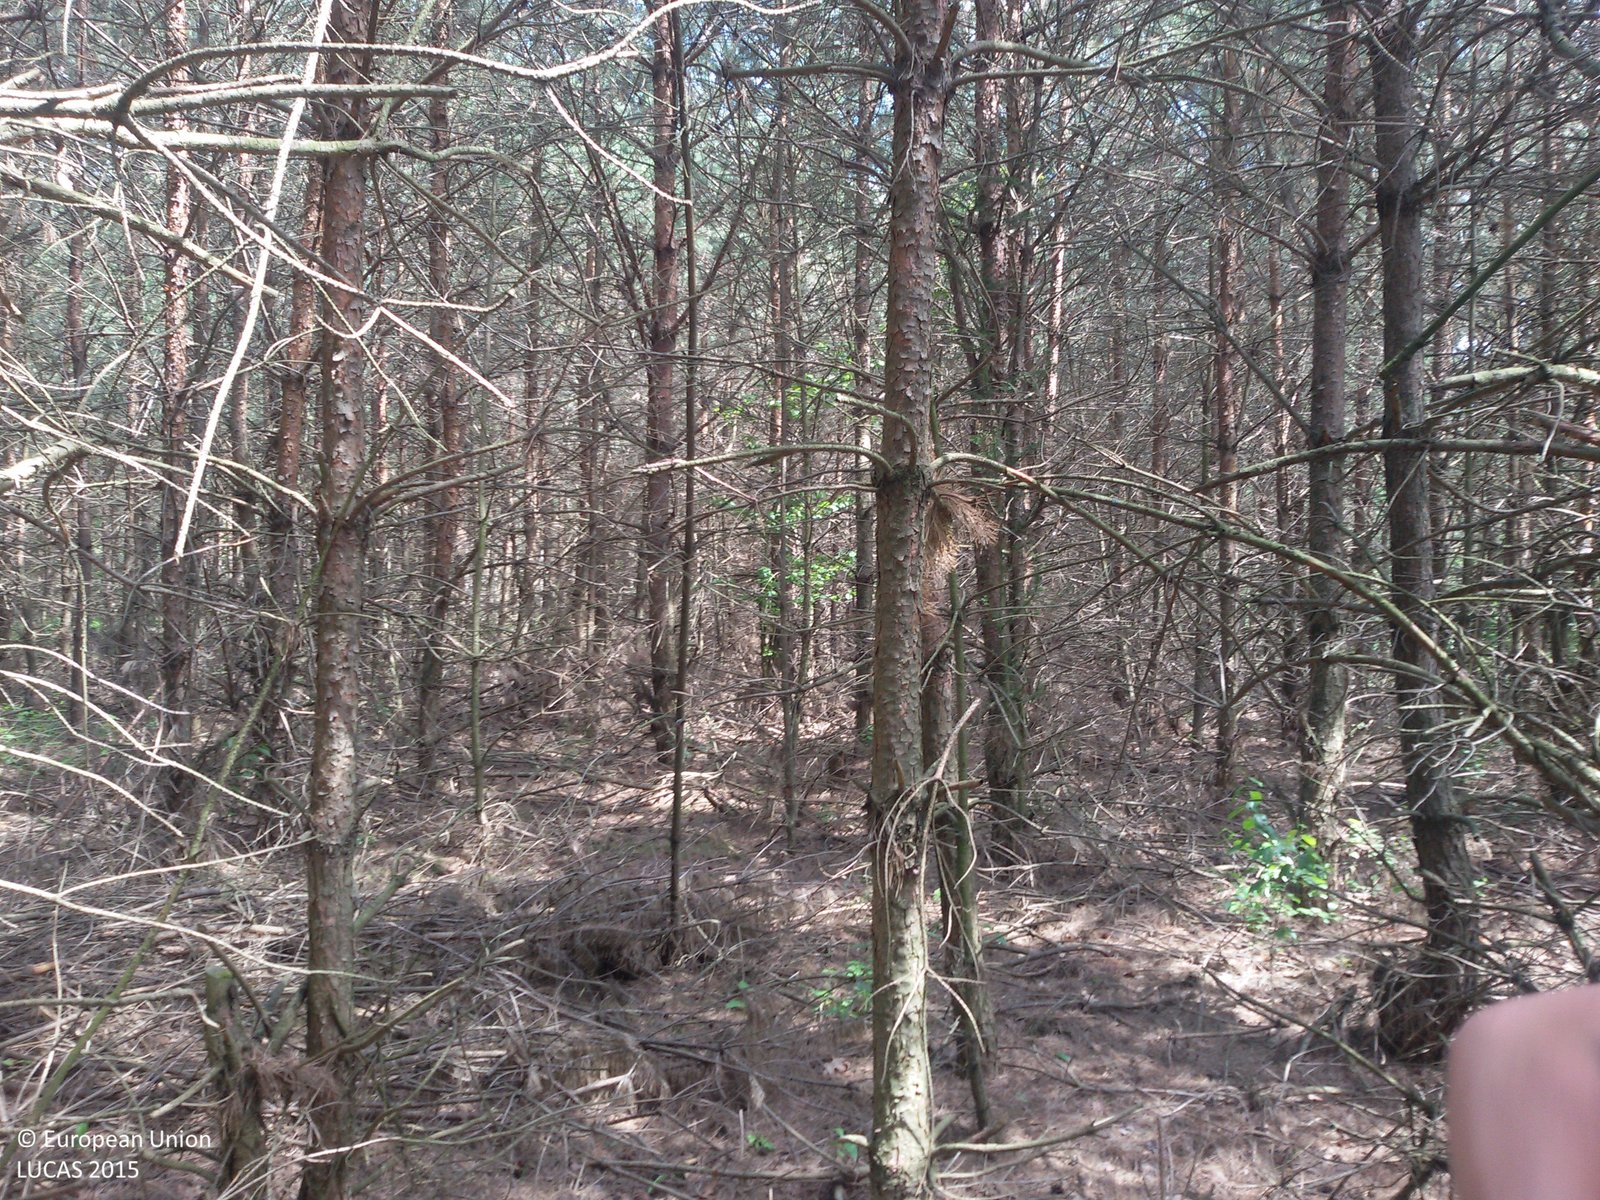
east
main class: Woodland
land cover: Pine dominated coniferous woodland
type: hemiboreal forest and nemoral coniferous forest and mixed broadleaved-coniferous forest
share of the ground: > 75 %
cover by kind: coniferous forest trees 90 %, broadleaved forest trees 5 %, shrubs 5 %
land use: Forestry
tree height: > 5 m
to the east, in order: Pine dominated coniferous woodland; Pine dominated mixed woodland; Pine dominated coniferous woodland
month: June
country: PL
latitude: 51.5174
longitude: 22.7964
